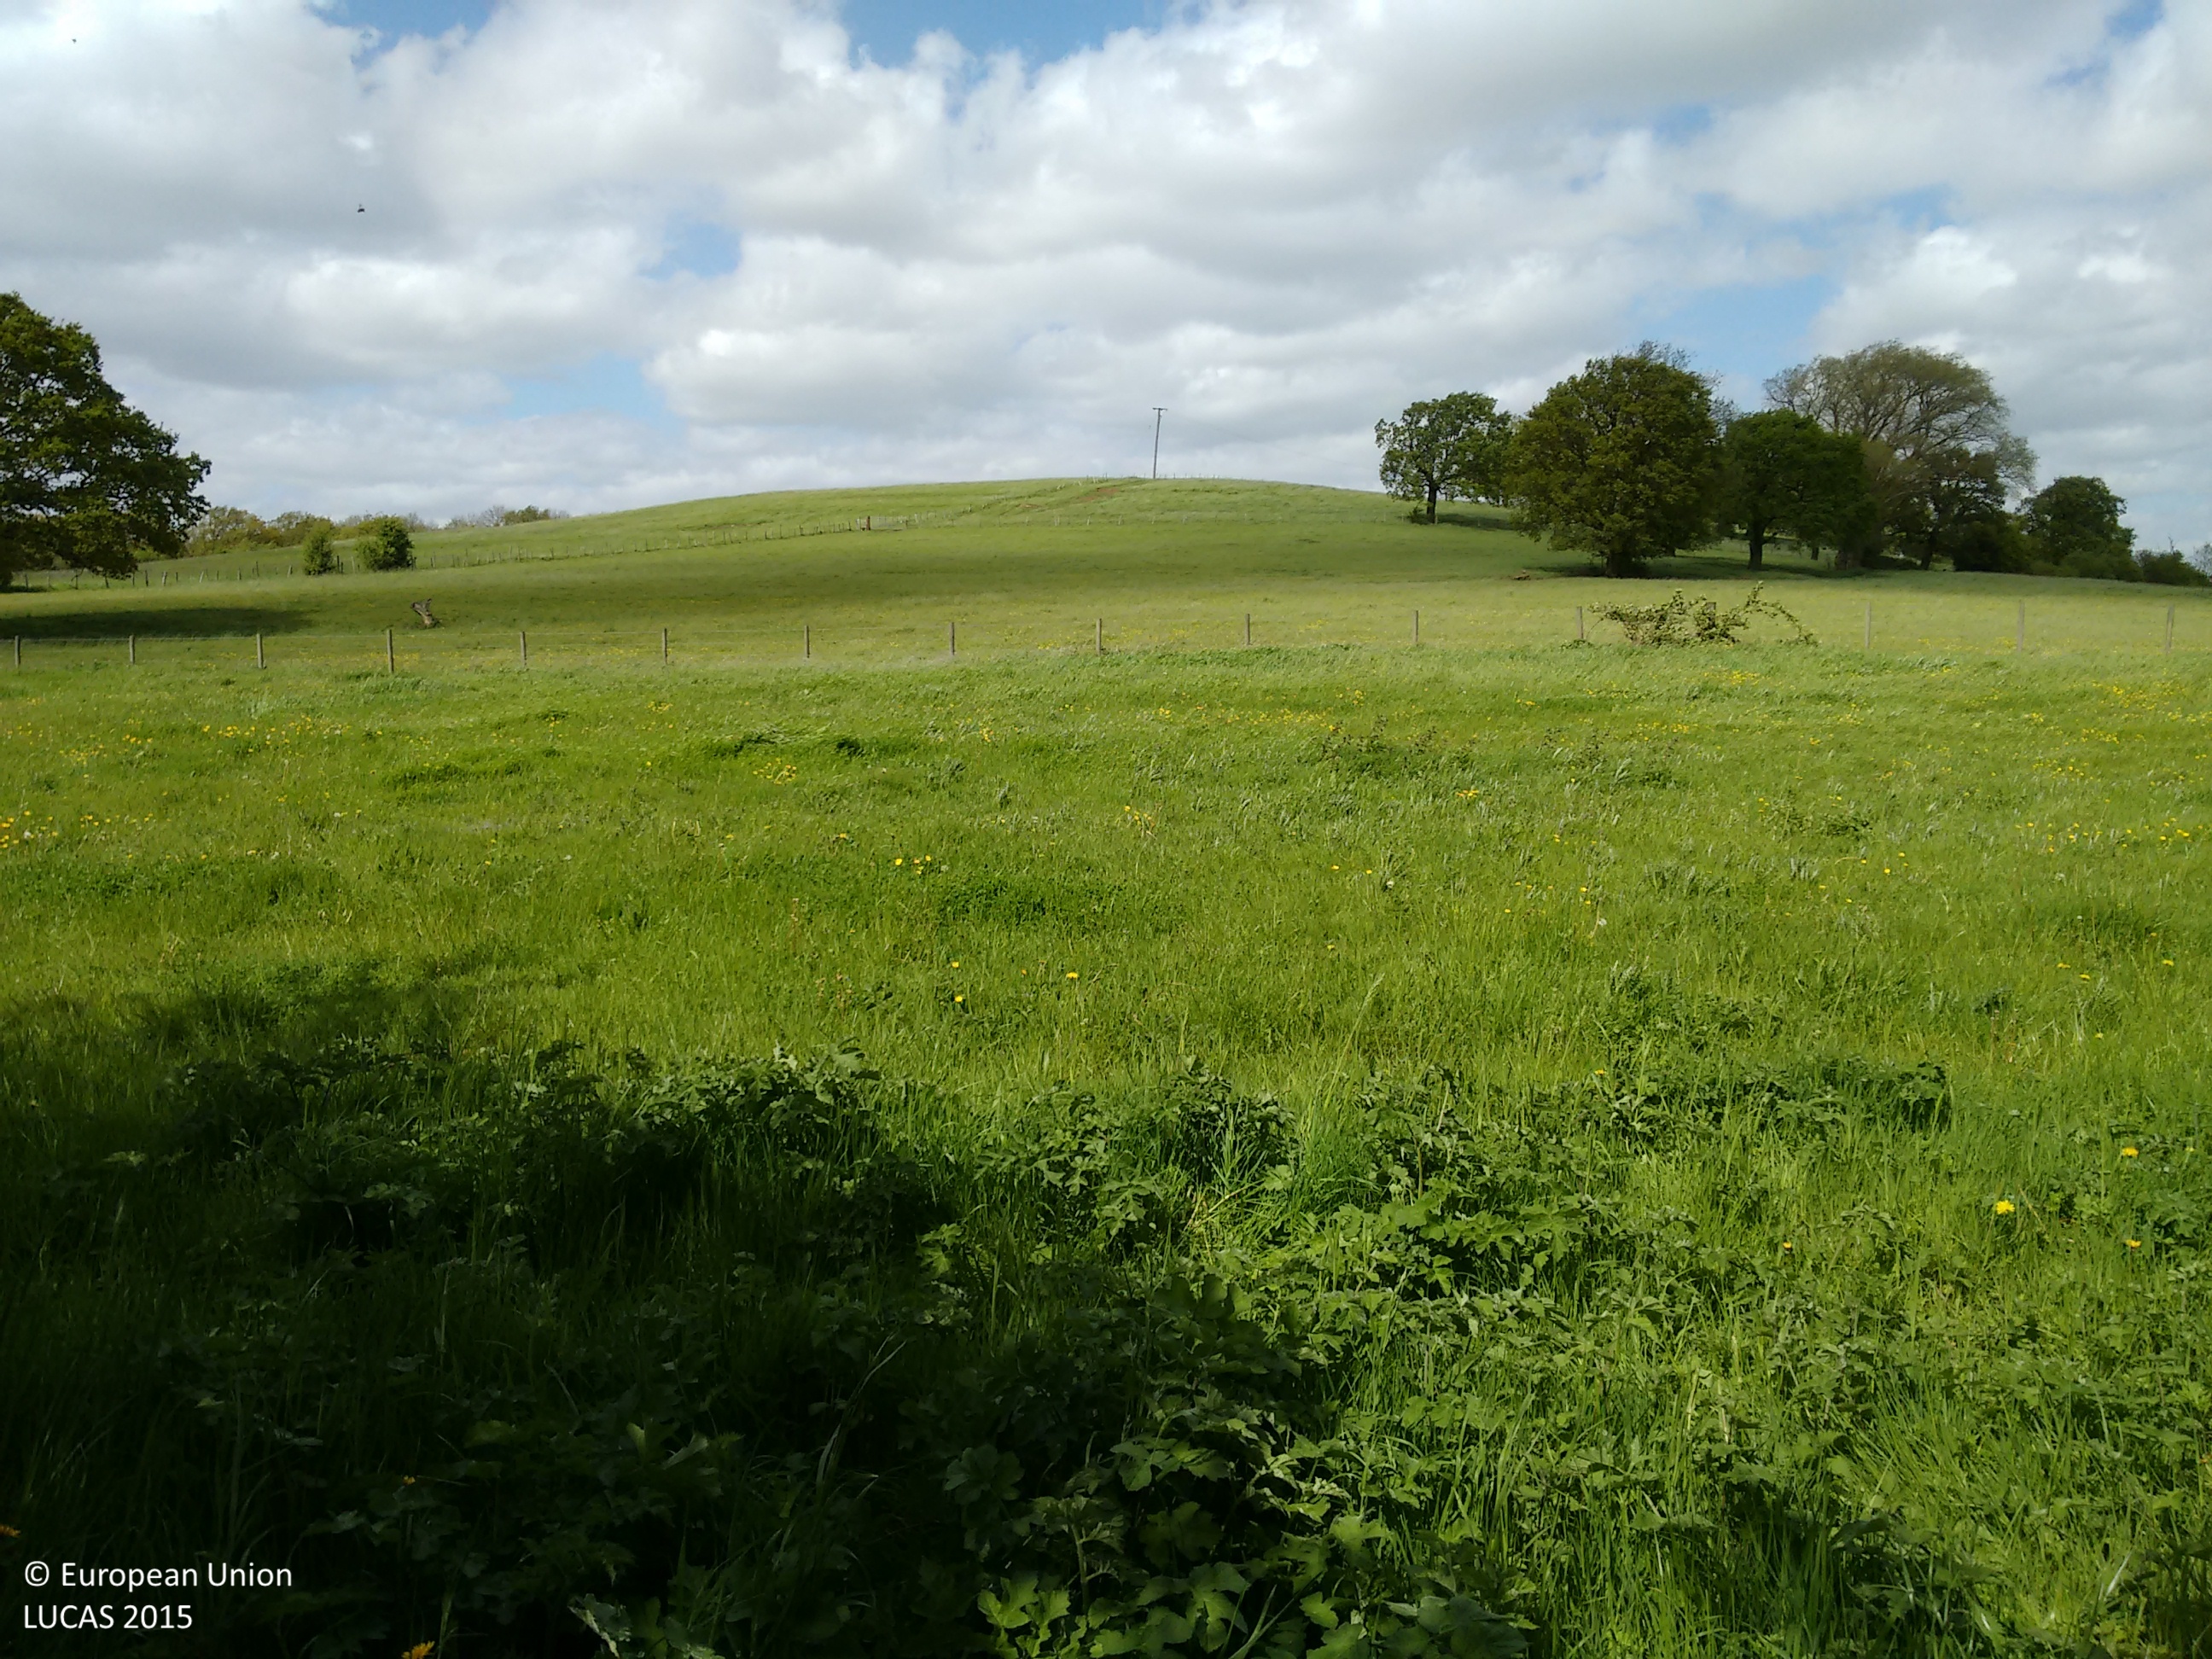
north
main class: Grassland
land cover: Grassland without tree/shrub cover
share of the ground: > 75 %
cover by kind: herbaceous plants 100 %
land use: Agriculture (excluding fallow land and kitchen gardens)
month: May
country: GB
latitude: 51.4173
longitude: 0.2928
